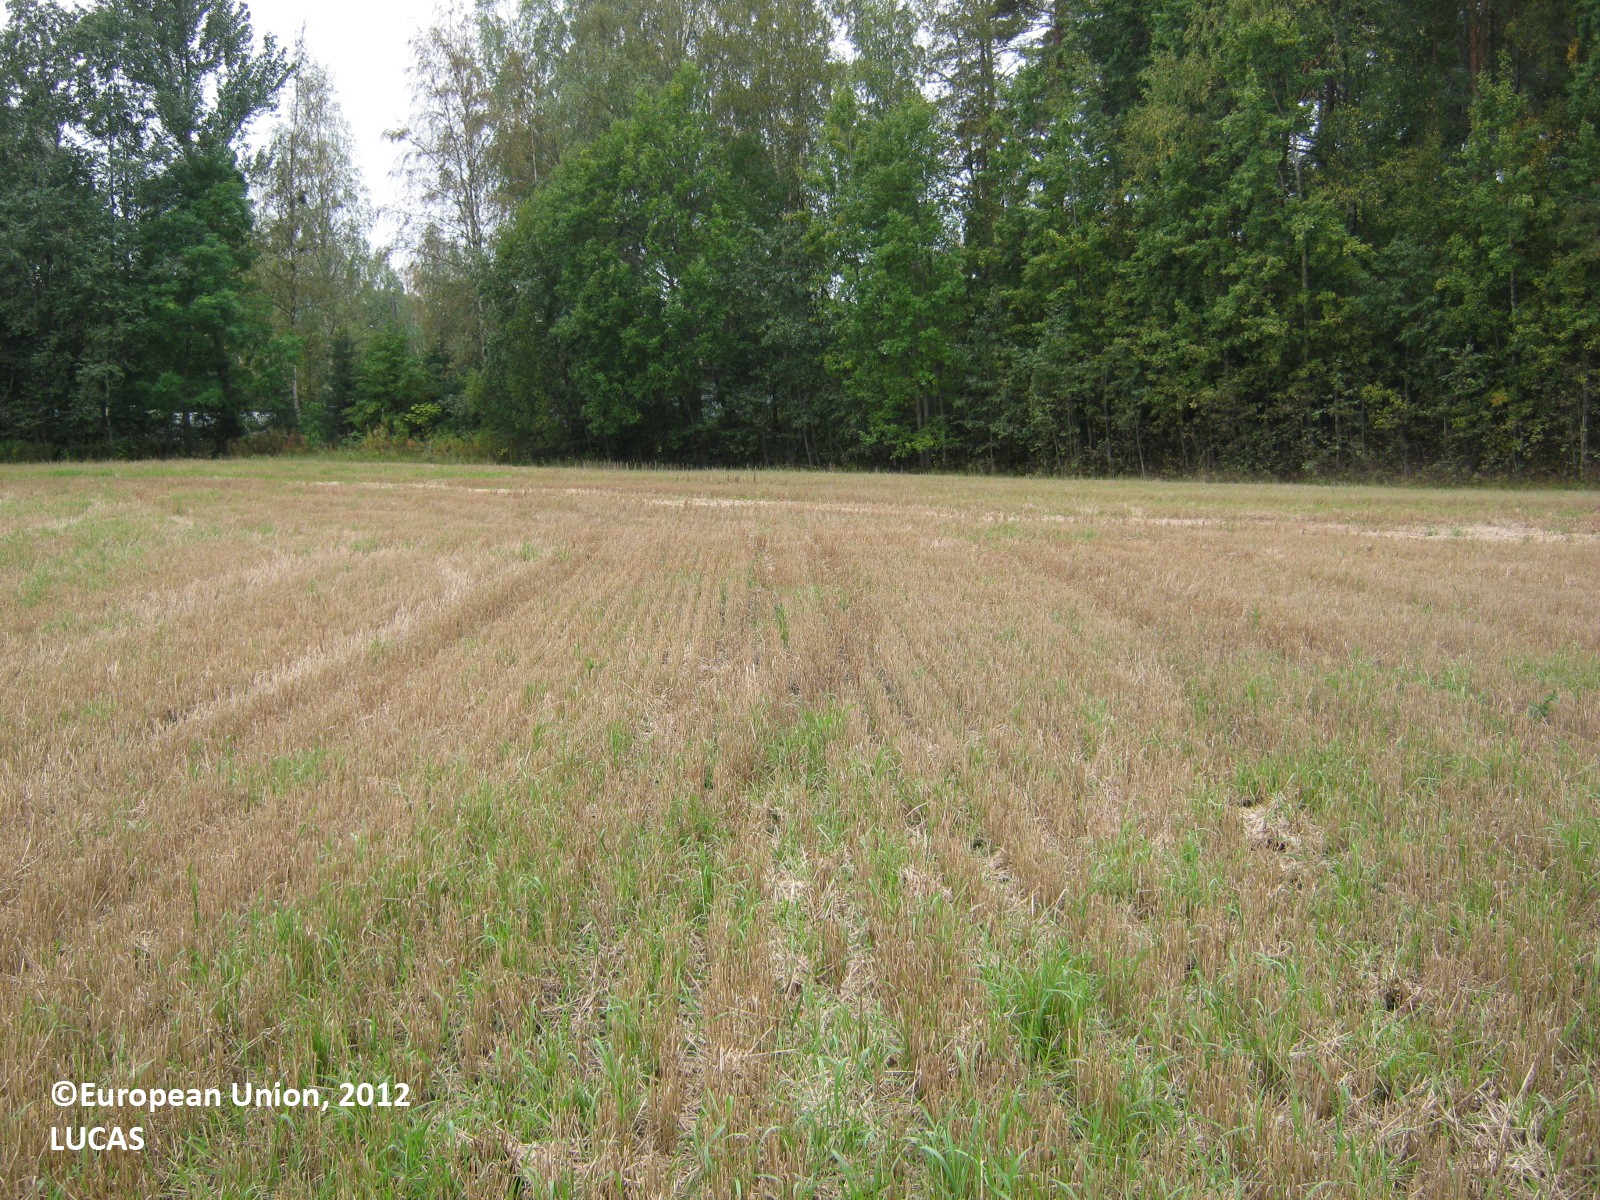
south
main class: Cropland
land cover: Barley
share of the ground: 50 - 75 %
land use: Agriculture (excluding fallow land and kitchen gardens)
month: September
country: FI
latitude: 60.5289
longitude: 27.5534
